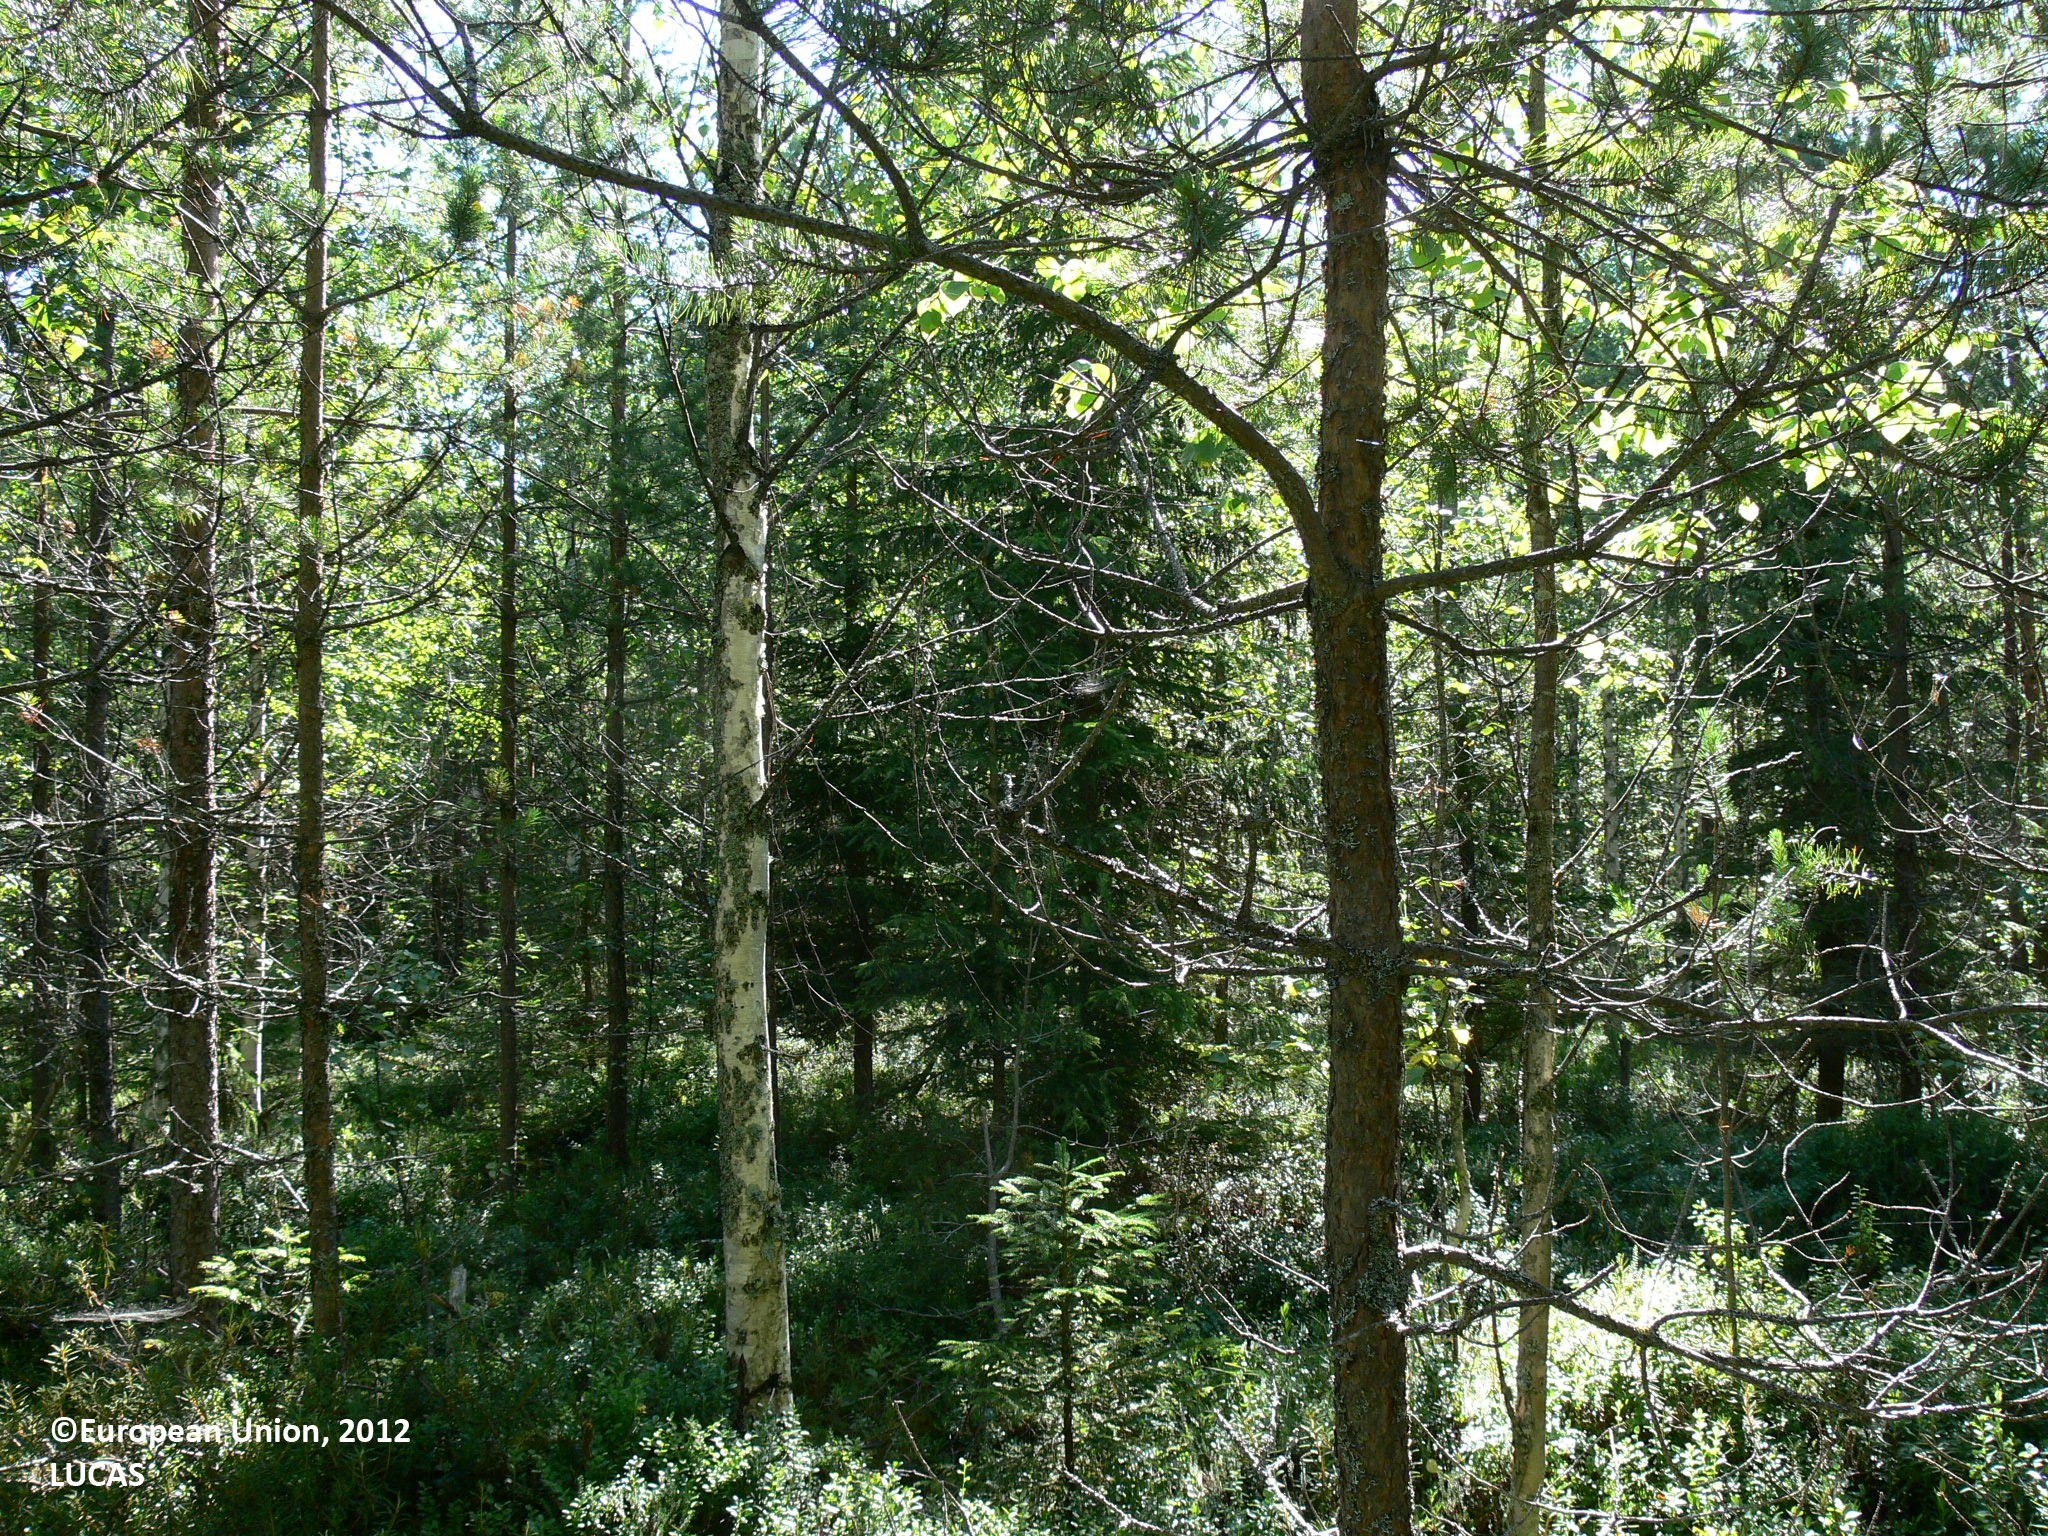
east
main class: Woodland
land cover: Other mixed woodland
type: boreal forest
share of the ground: 50 - 75 %
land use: Forestry
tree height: > 5 m
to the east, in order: Other mixed woodland; Ditches and canals; Other mixed woodland; Ditches and canals; Other mixed woodland; Ditches and canals; Pine dominated coniferous woodland; Other coniferous woodland; Ditches and canals; Spontaneously vegetated surfaces; Ditches and canals; Spontaneously vegetated surfaces; Spruce dominated coniferous woodland; Ditches and canals; Spruce dominated coniferous woodland; Ditches and canals; Spruce dominated coniferous woodland; Ditches and canals; Grassland without tree/shrub cover; Electric lines; Grassland without tree/shrub cover
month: July
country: FI
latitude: 63.0676
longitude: 29.4048
